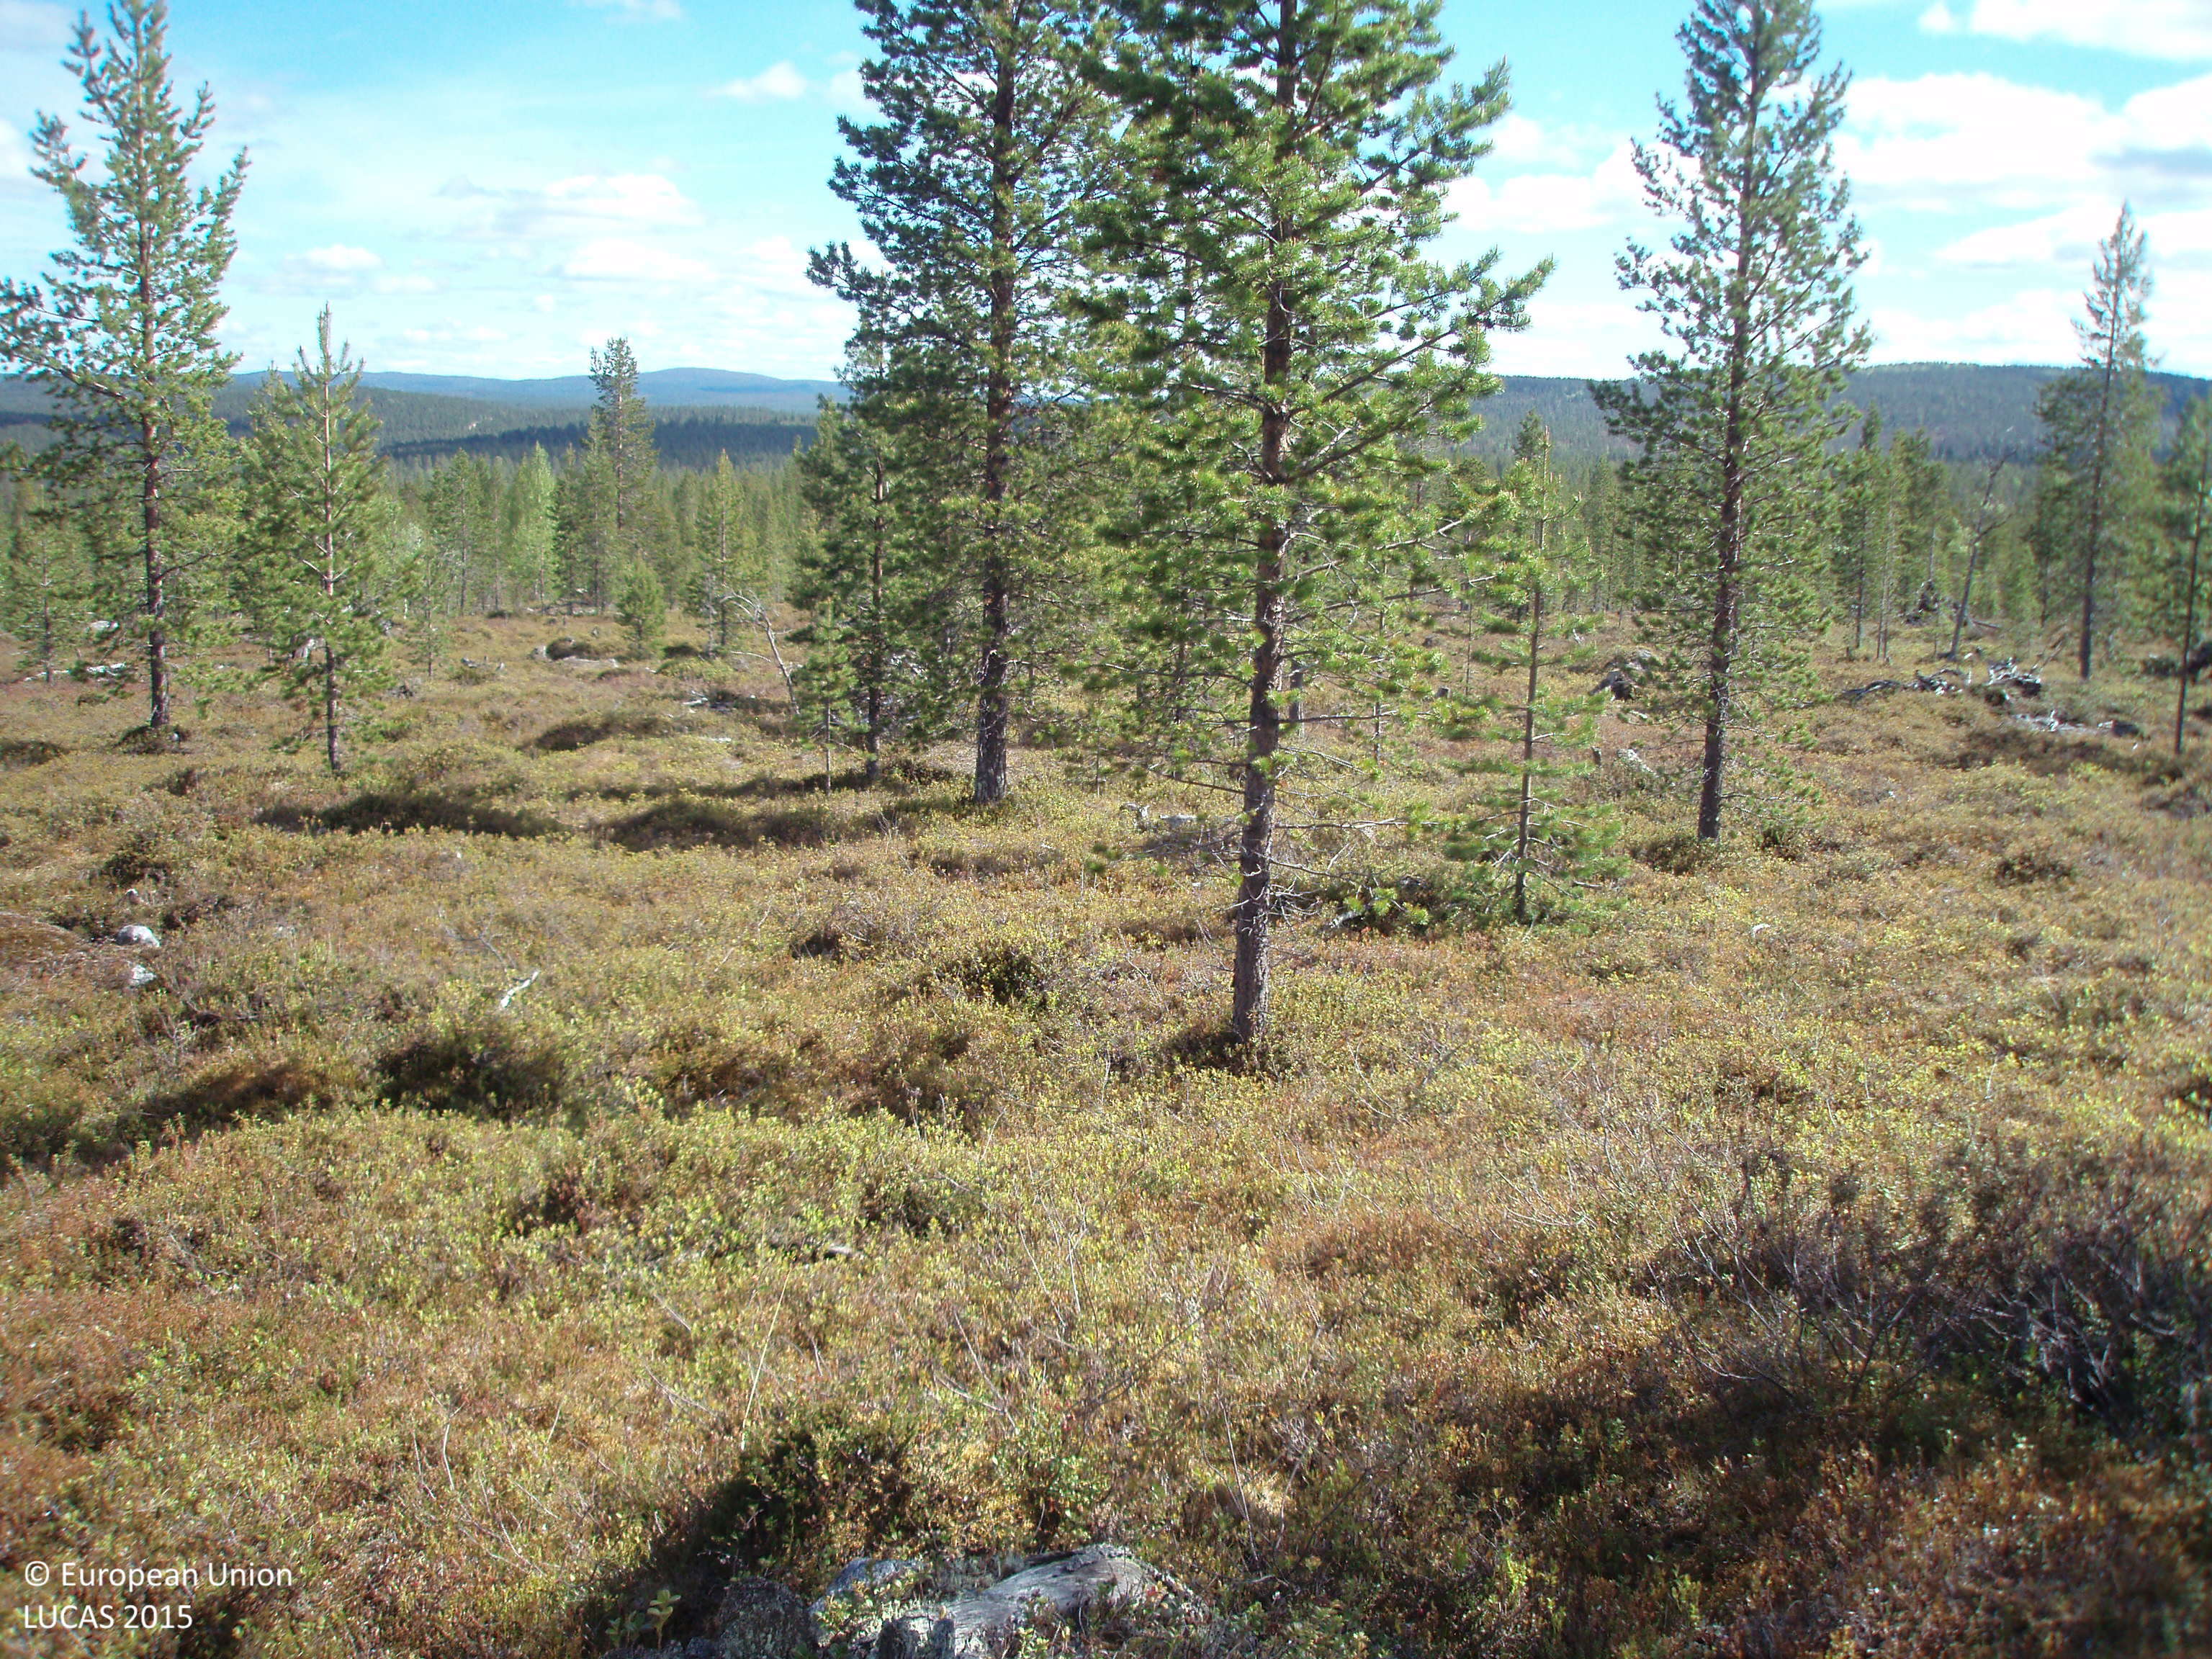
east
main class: Woodland
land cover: Pine dominated coniferous woodland
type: boreal forest
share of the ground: 25 - 50 %
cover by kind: shrubs 50 %, coniferous forest trees 35 %, lichens and mosses 10 %, broadleaved forest trees 5 %
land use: Forestry
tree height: > 5 m
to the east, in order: Pine dominated coniferous woodland
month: June
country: FI
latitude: 68.6269
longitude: 28.0168
